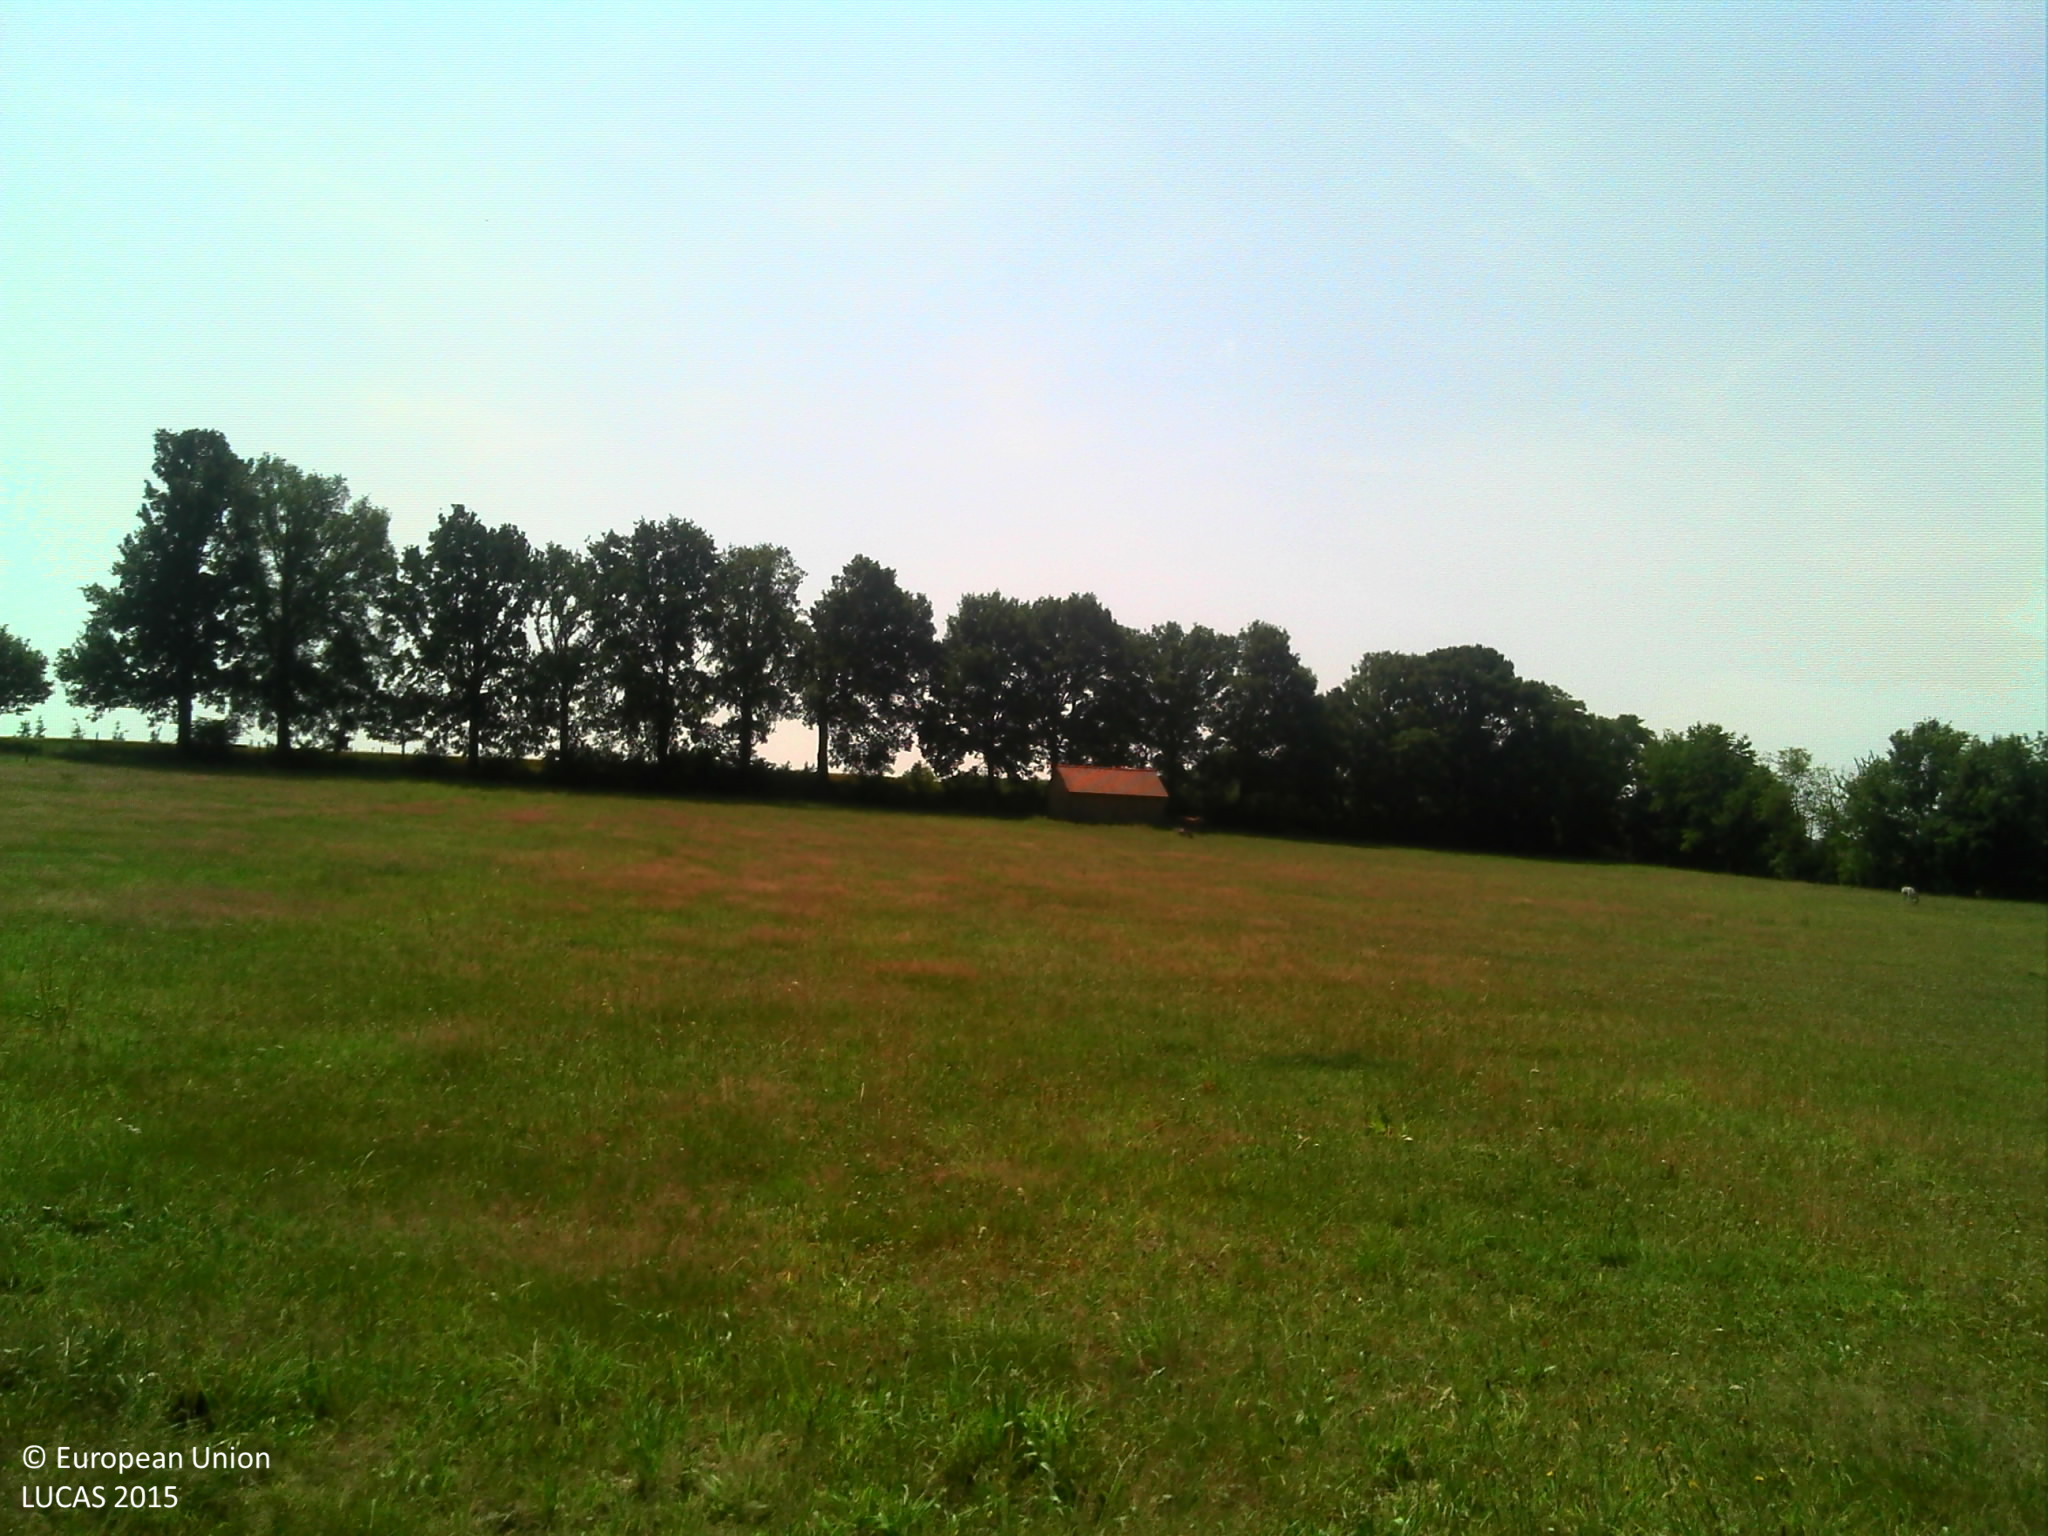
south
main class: Grassland
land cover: Grassland without tree/shrub cover
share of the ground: > 75 %
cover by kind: herbaceous plants 95 %, shrubs 5 %
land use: Agriculture (excluding fallow land and kitchen gardens)
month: July
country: BE
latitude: 50.9319
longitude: 4.8316
